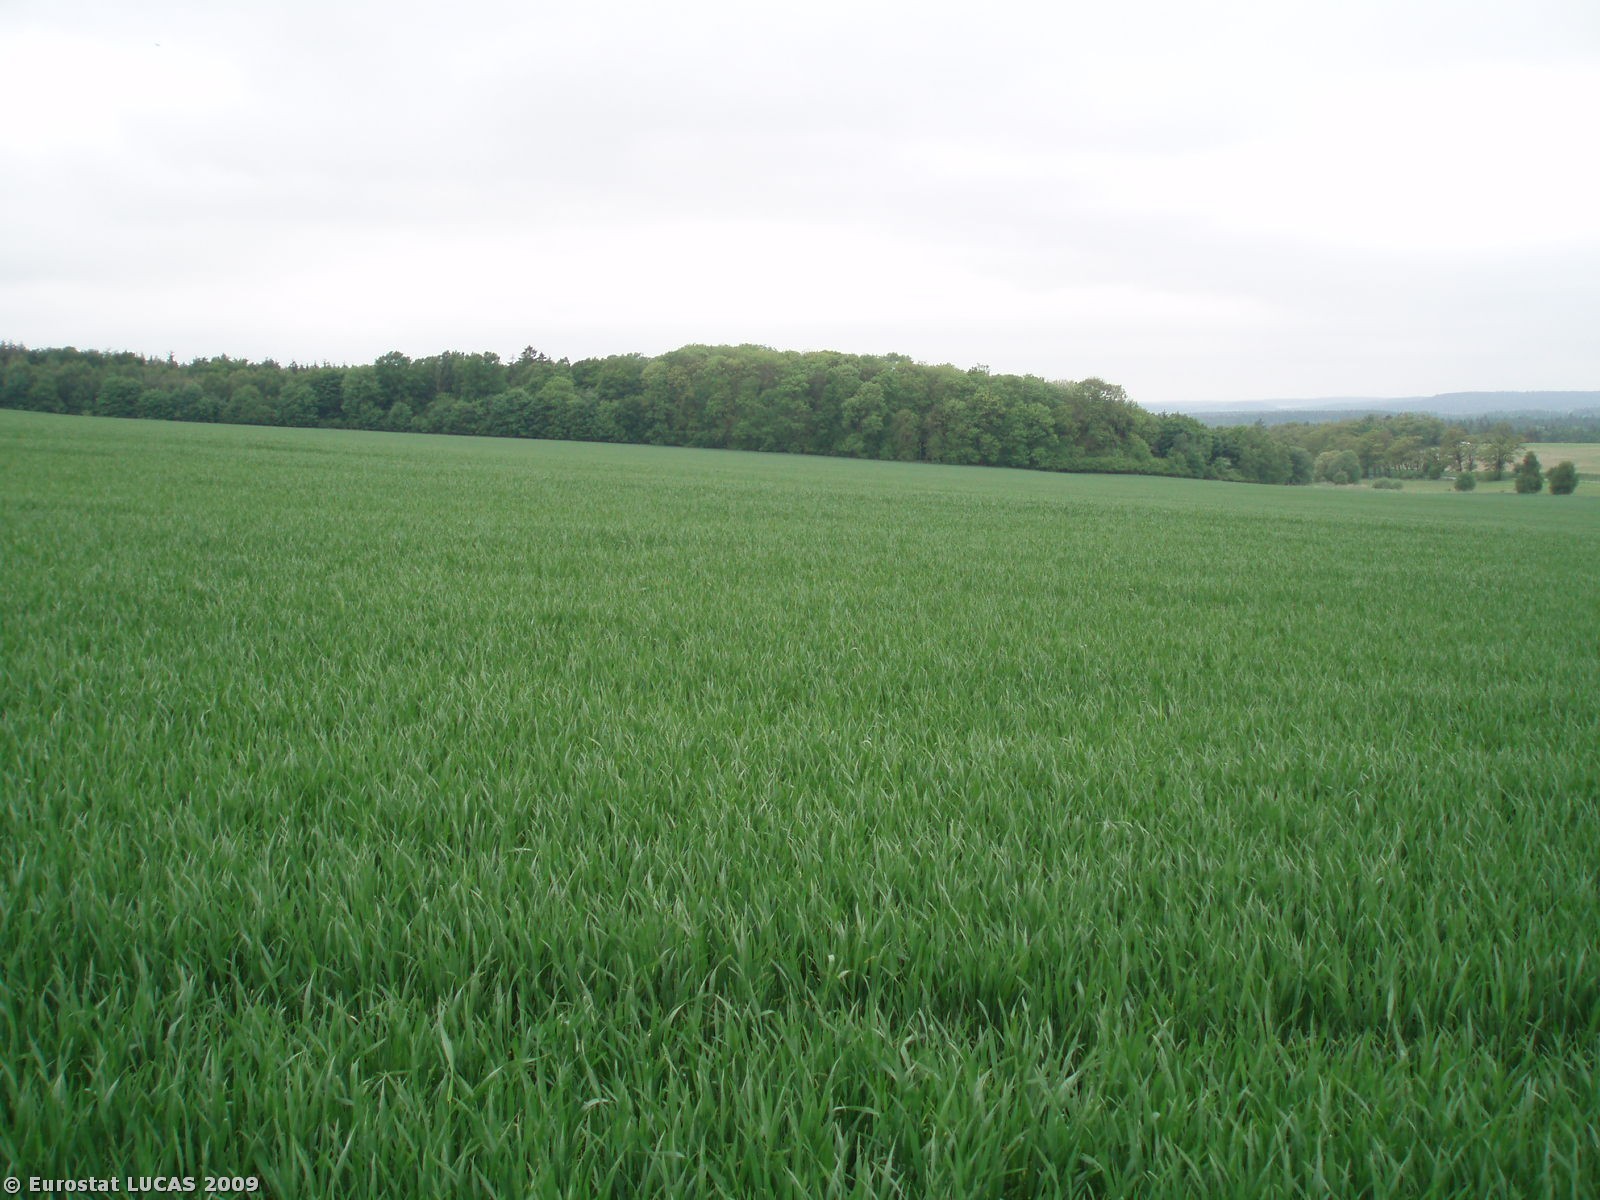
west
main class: Cropland
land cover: Common wheat
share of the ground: > 75 %
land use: Agriculture (excluding fallow land and kitchen gardens)
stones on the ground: < 10 %
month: May
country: CZ
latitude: 50.0547
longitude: 14.1493
